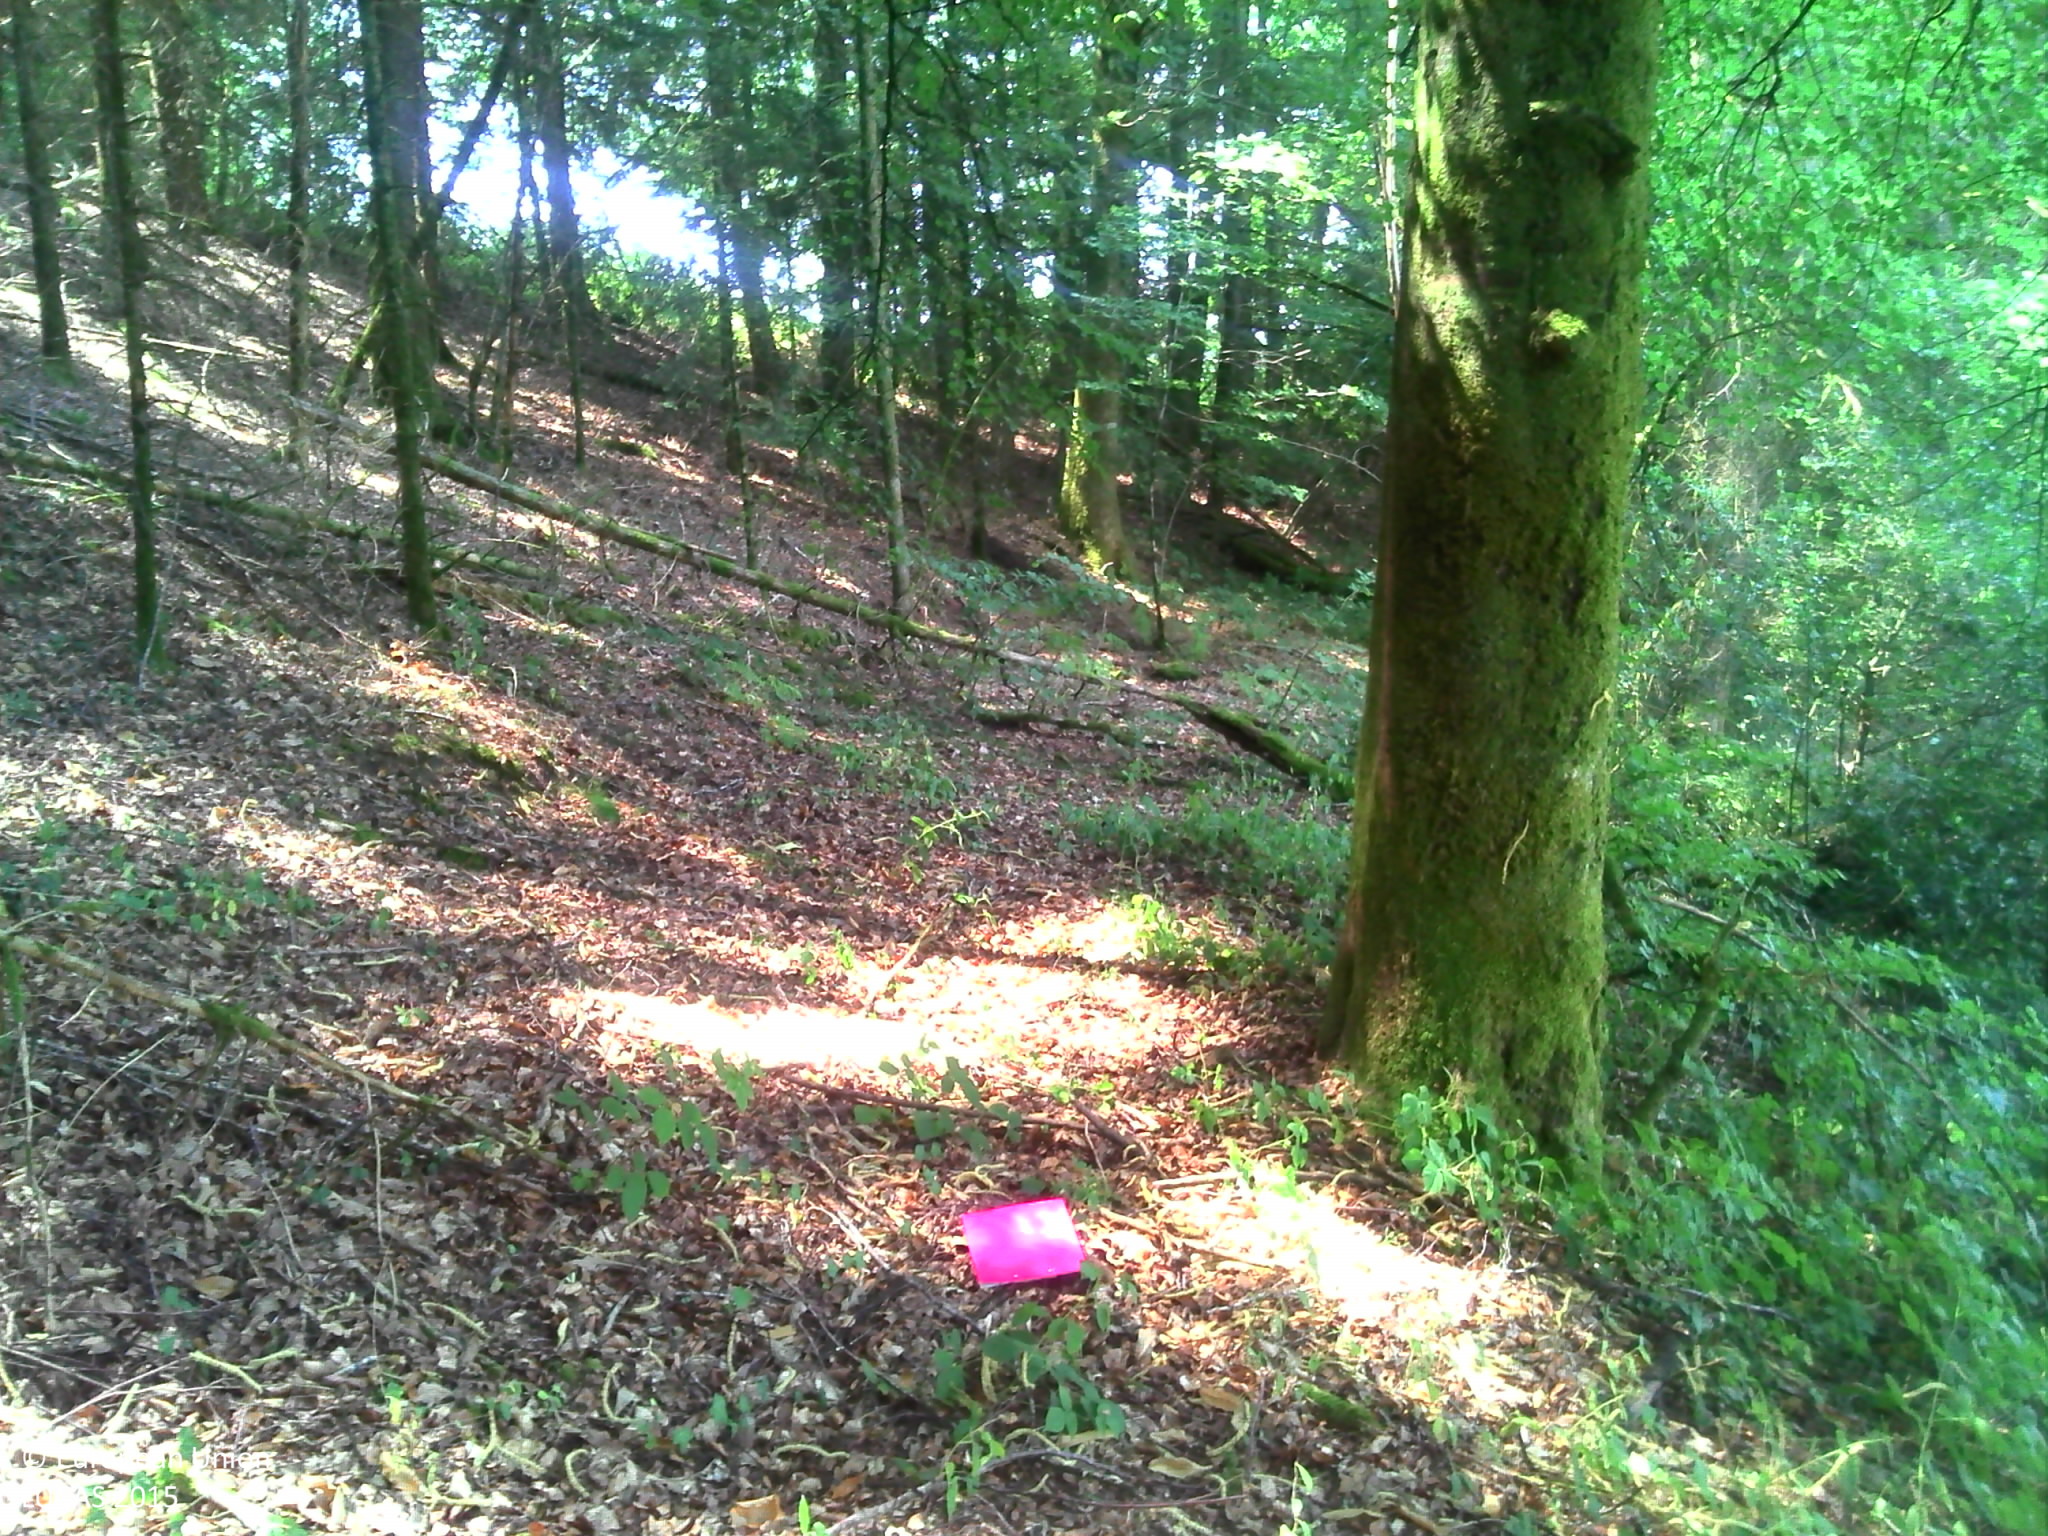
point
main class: Woodland
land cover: Spruce dominated mixed woodland
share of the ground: > 75 %
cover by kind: coniferous forest trees 45 %, broadleaved forest trees 40 %, shrubs 5 %, herbaceous plants 5 %, lichens and mosses 5 %
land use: Forestry
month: July
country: FR
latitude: 45.9457
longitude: 1.8021
